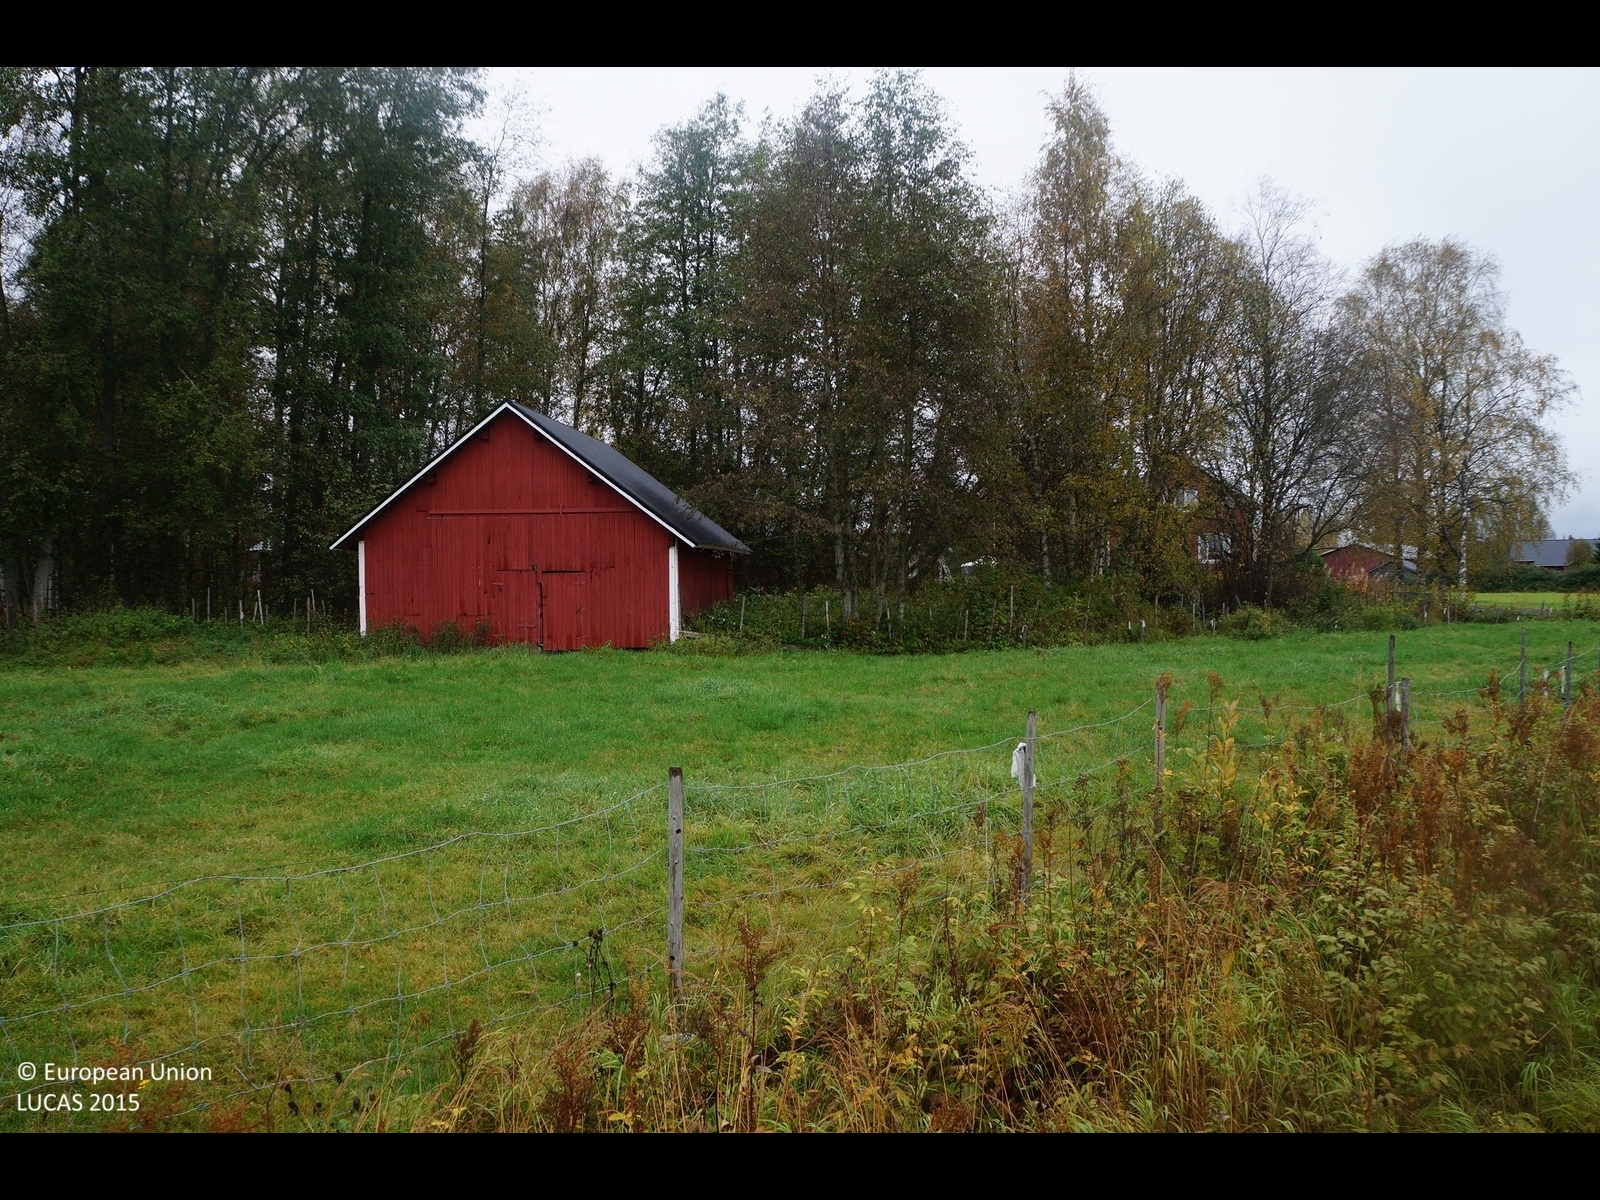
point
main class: Woodland
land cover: Broadleaved woodland
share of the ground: > 75 %
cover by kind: broadleaved forest trees 75 %, herbaceous plants 15 %, shrubs 10 %
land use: Forestry
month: September
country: FI
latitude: 64.1323
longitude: 24.3058
